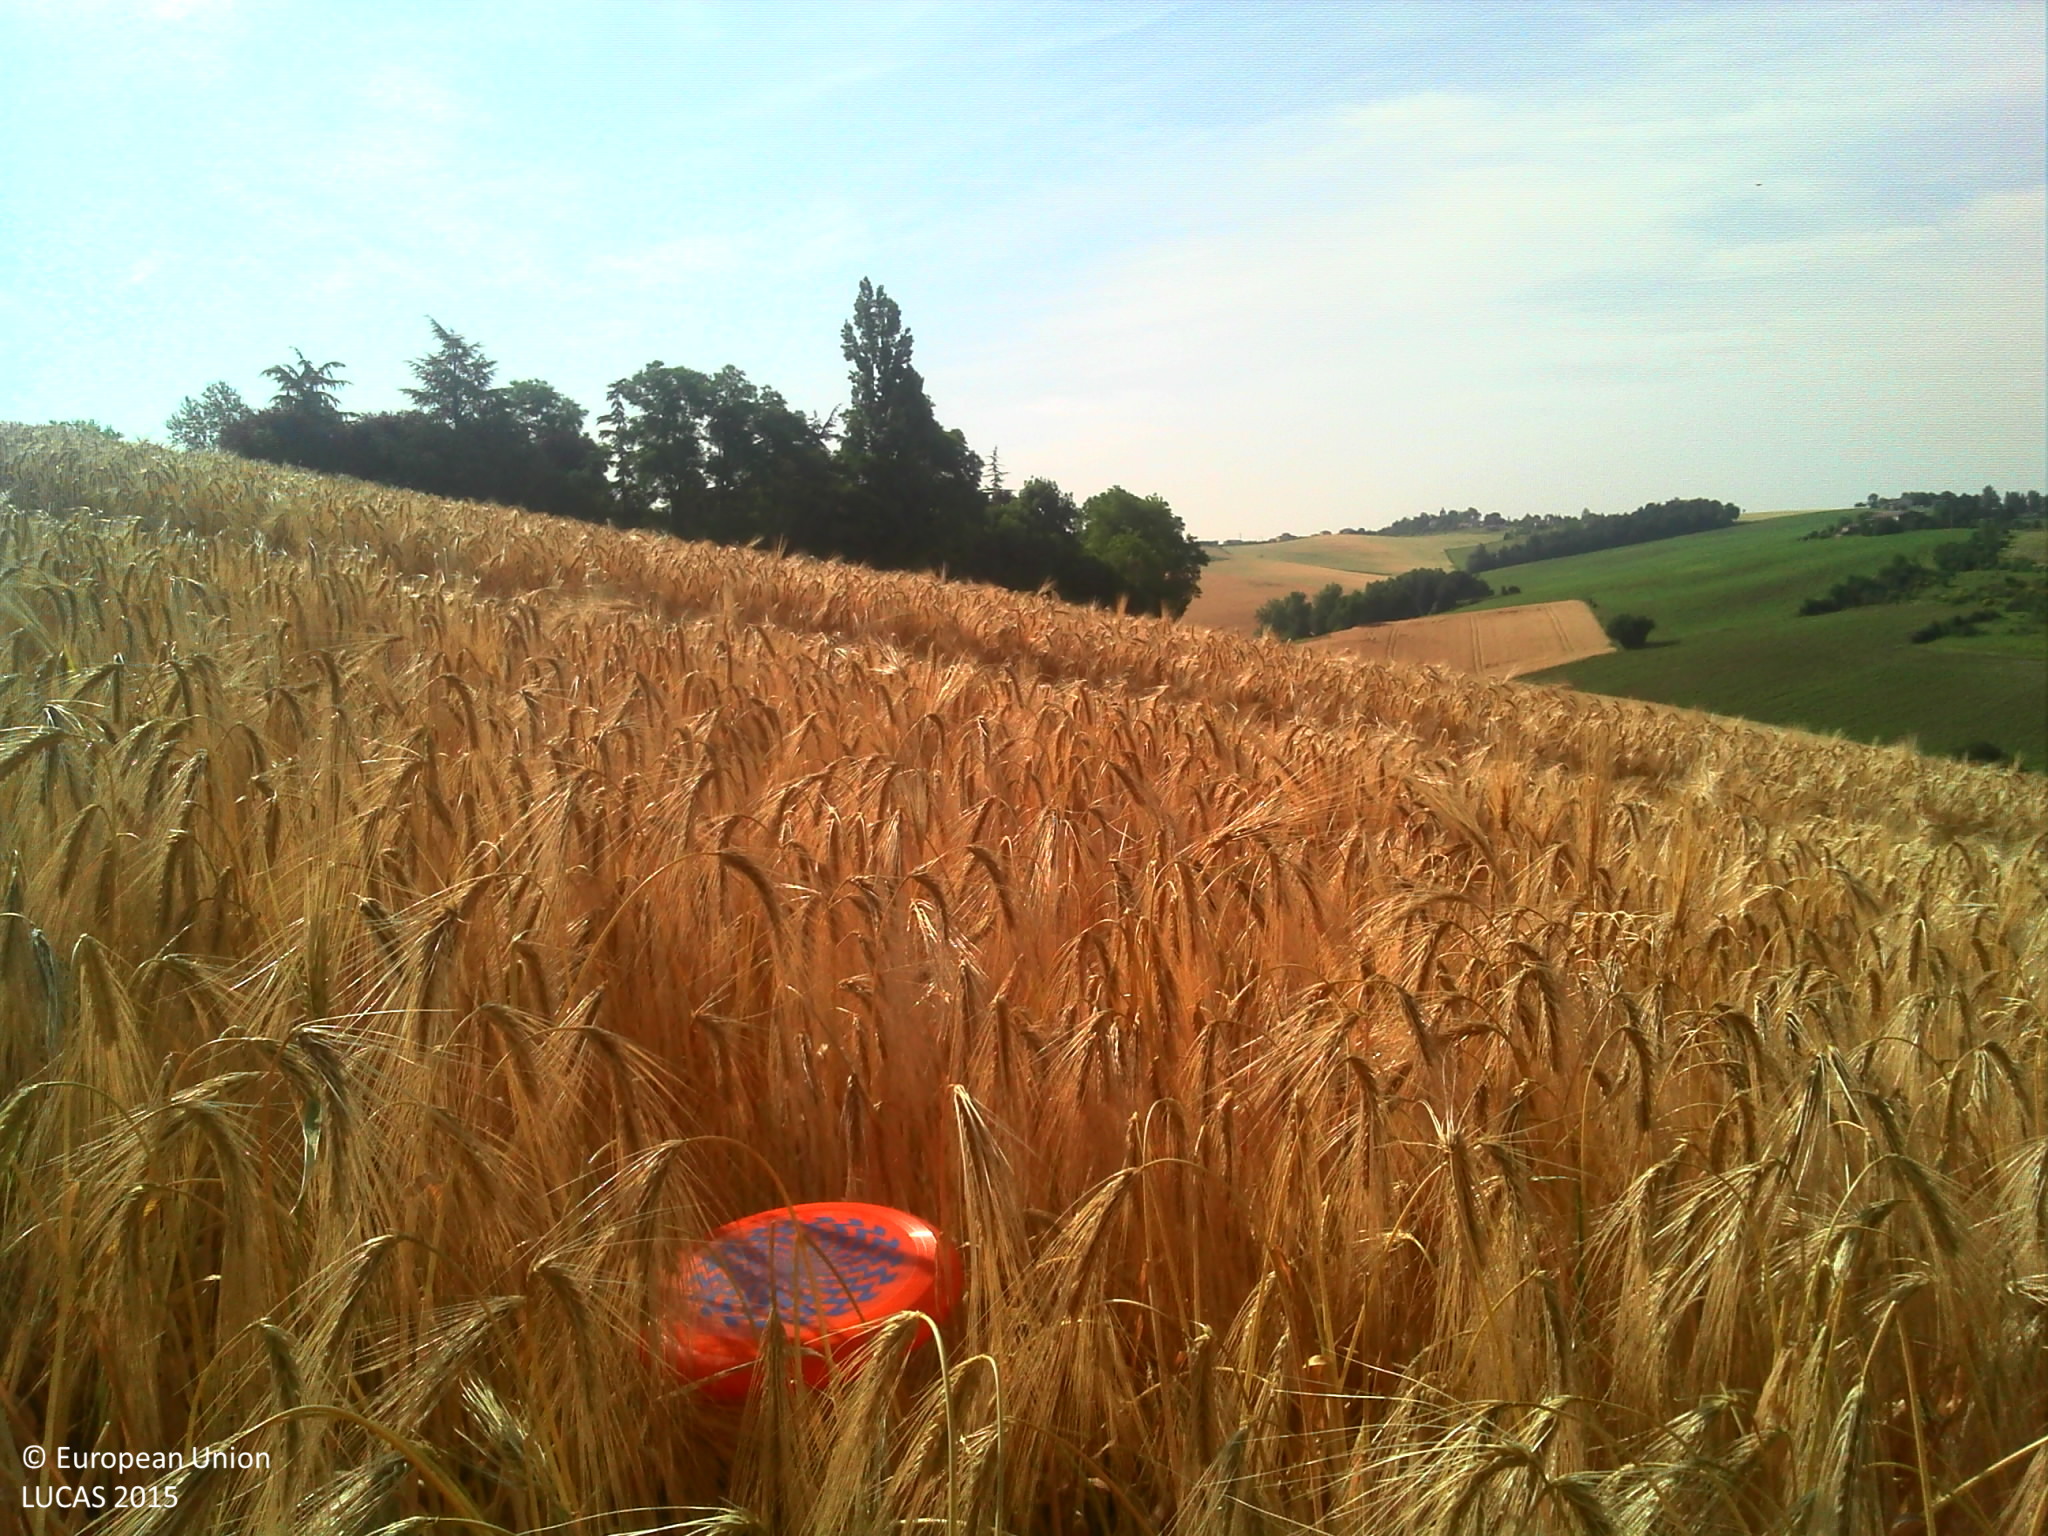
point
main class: Cropland
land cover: Barley
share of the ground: > 75 %
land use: Agriculture (excluding fallow land and kitchen gardens)
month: June
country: FR
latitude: 43.6398
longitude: 1.7355
